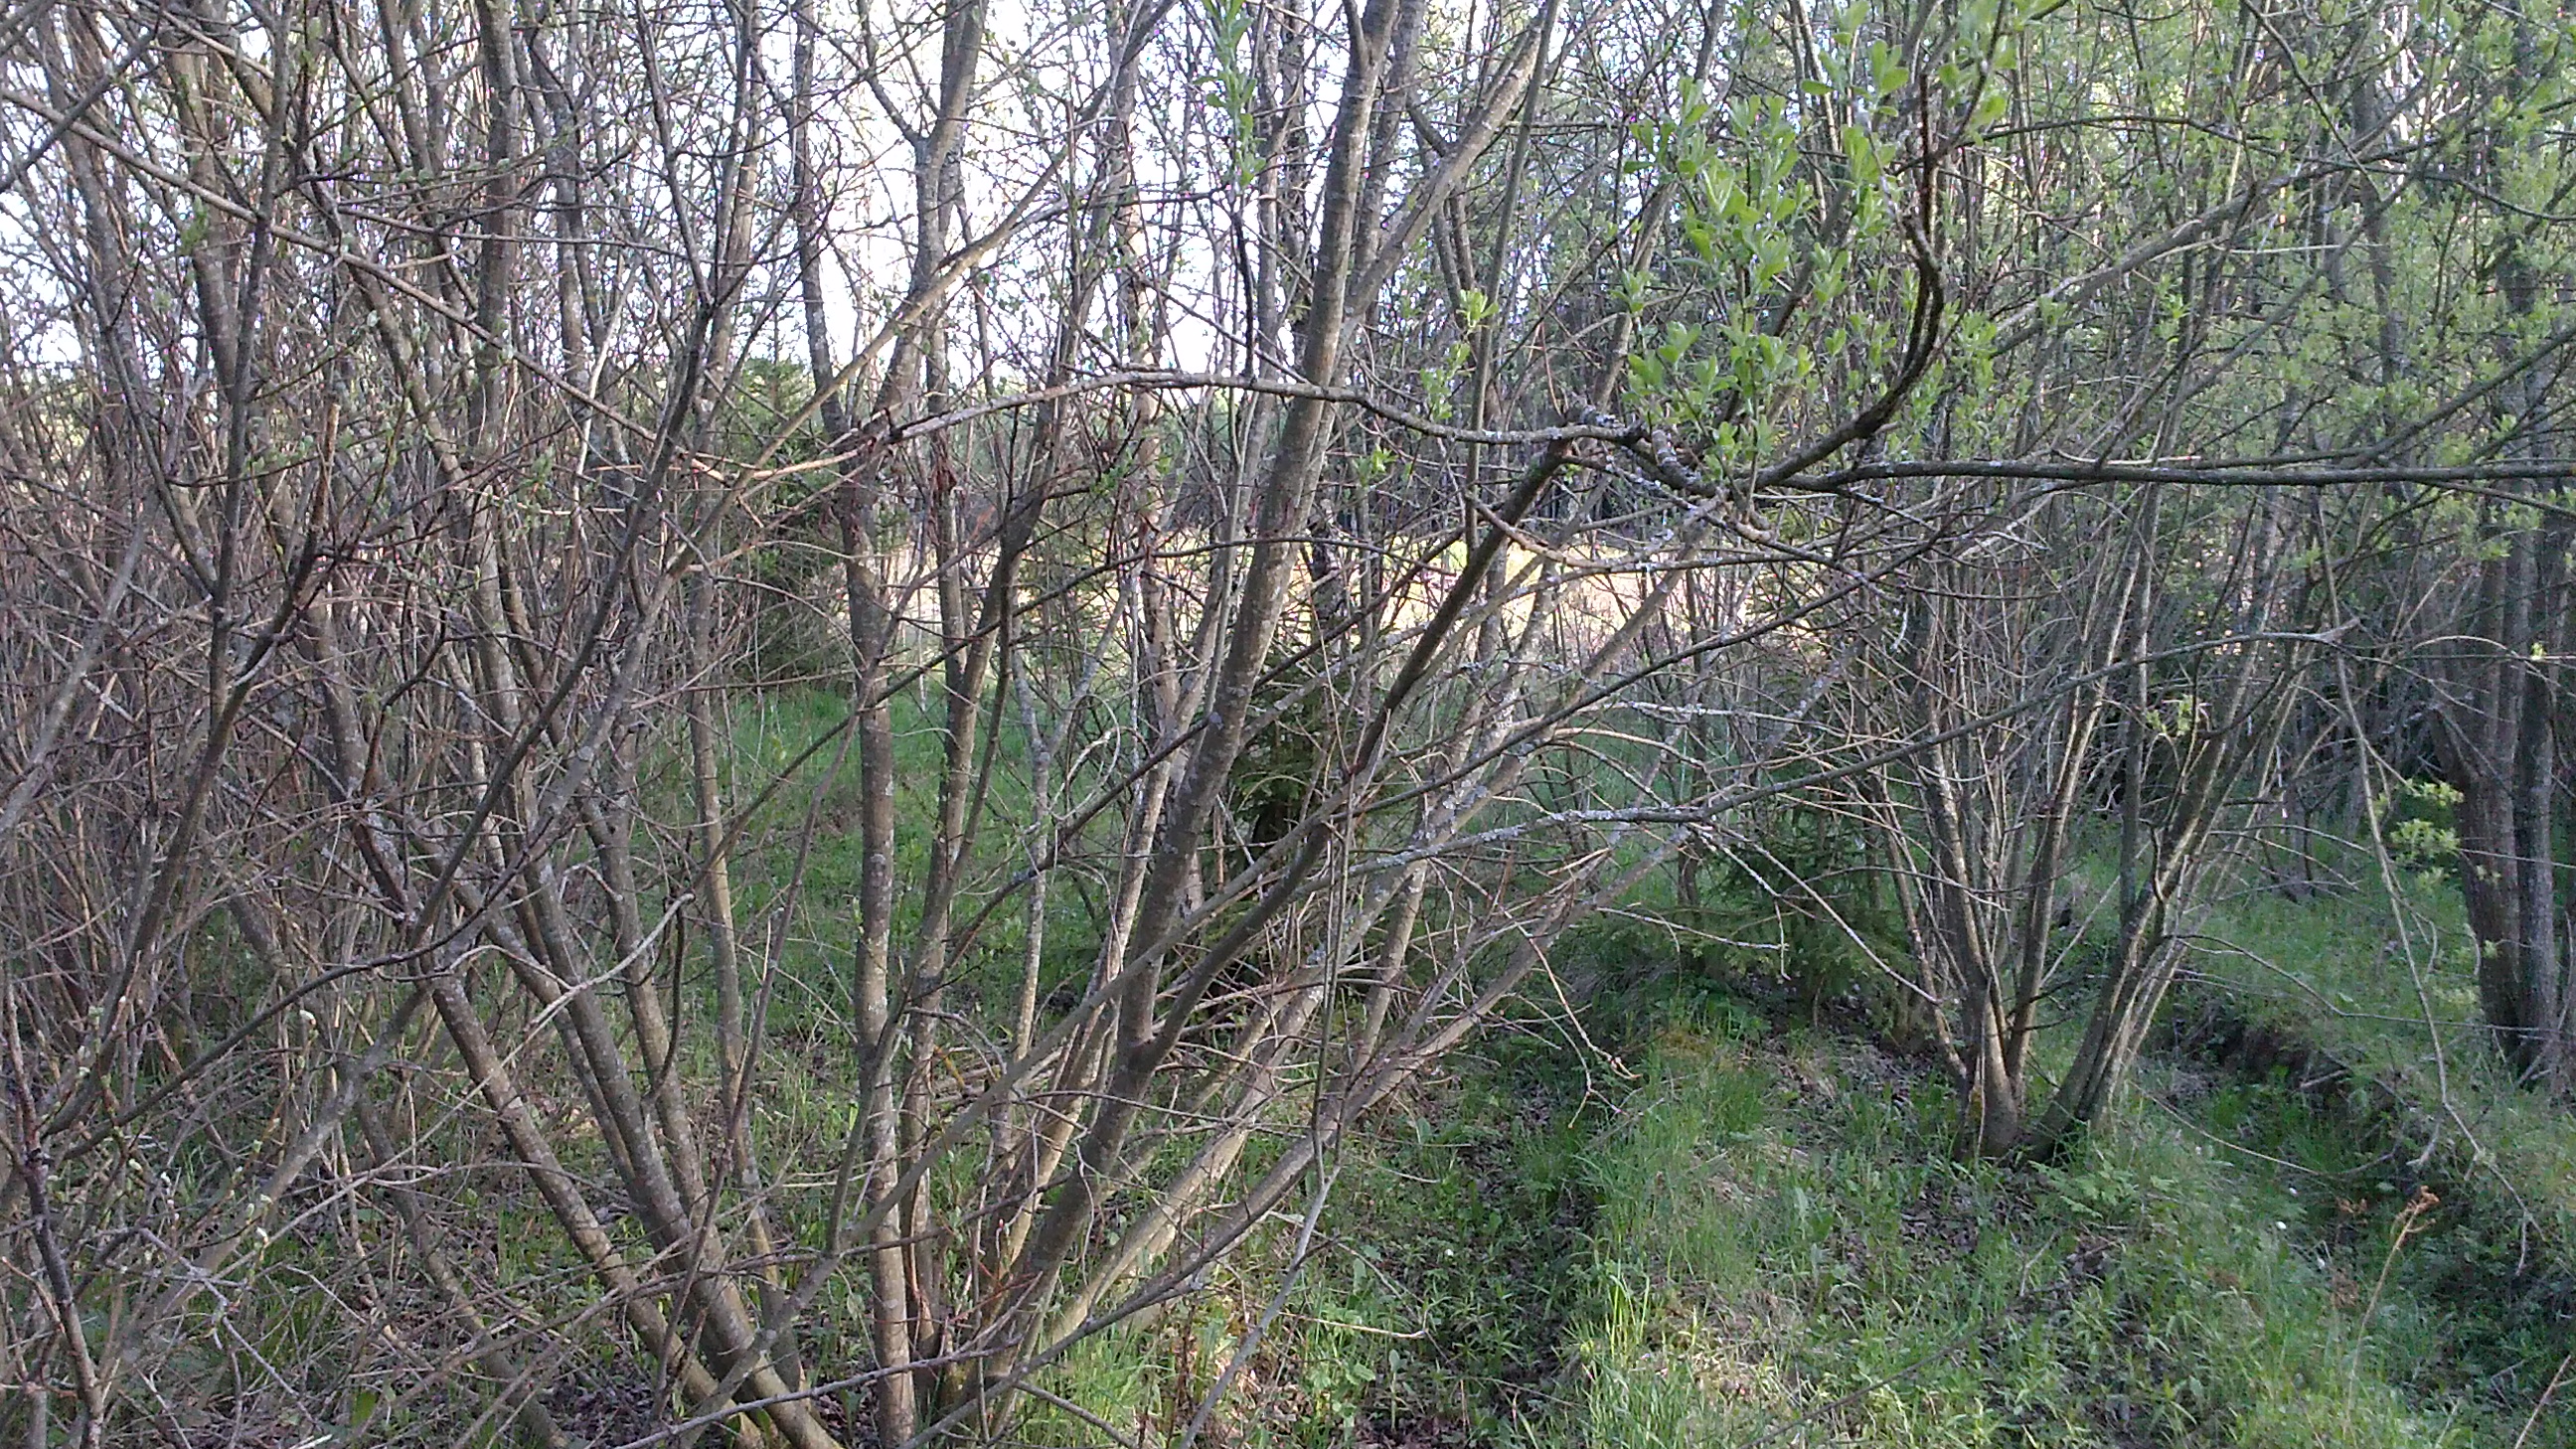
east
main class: Woodland
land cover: Spruce dominated mixed woodland
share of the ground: > 75 %
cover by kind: coniferous forest trees 75 %, broadleaved forest trees 25 %
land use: Forestry
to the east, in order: Spruce dominated mixed woodland; Broadleaved woodland; Grassland with sparse tree/shrub cover; Grassland without tree/shrub cover; Broadleaved woodland; Grassland without tree/shrub cover; Grassland with sparse tree/shrub cover; Ditches and canals; Grassland with sparse tree/shrub cover; Grassland without tree/shrub cover; Broadleaved woodland
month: May
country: LV
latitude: 56.0926
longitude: 27.2591
